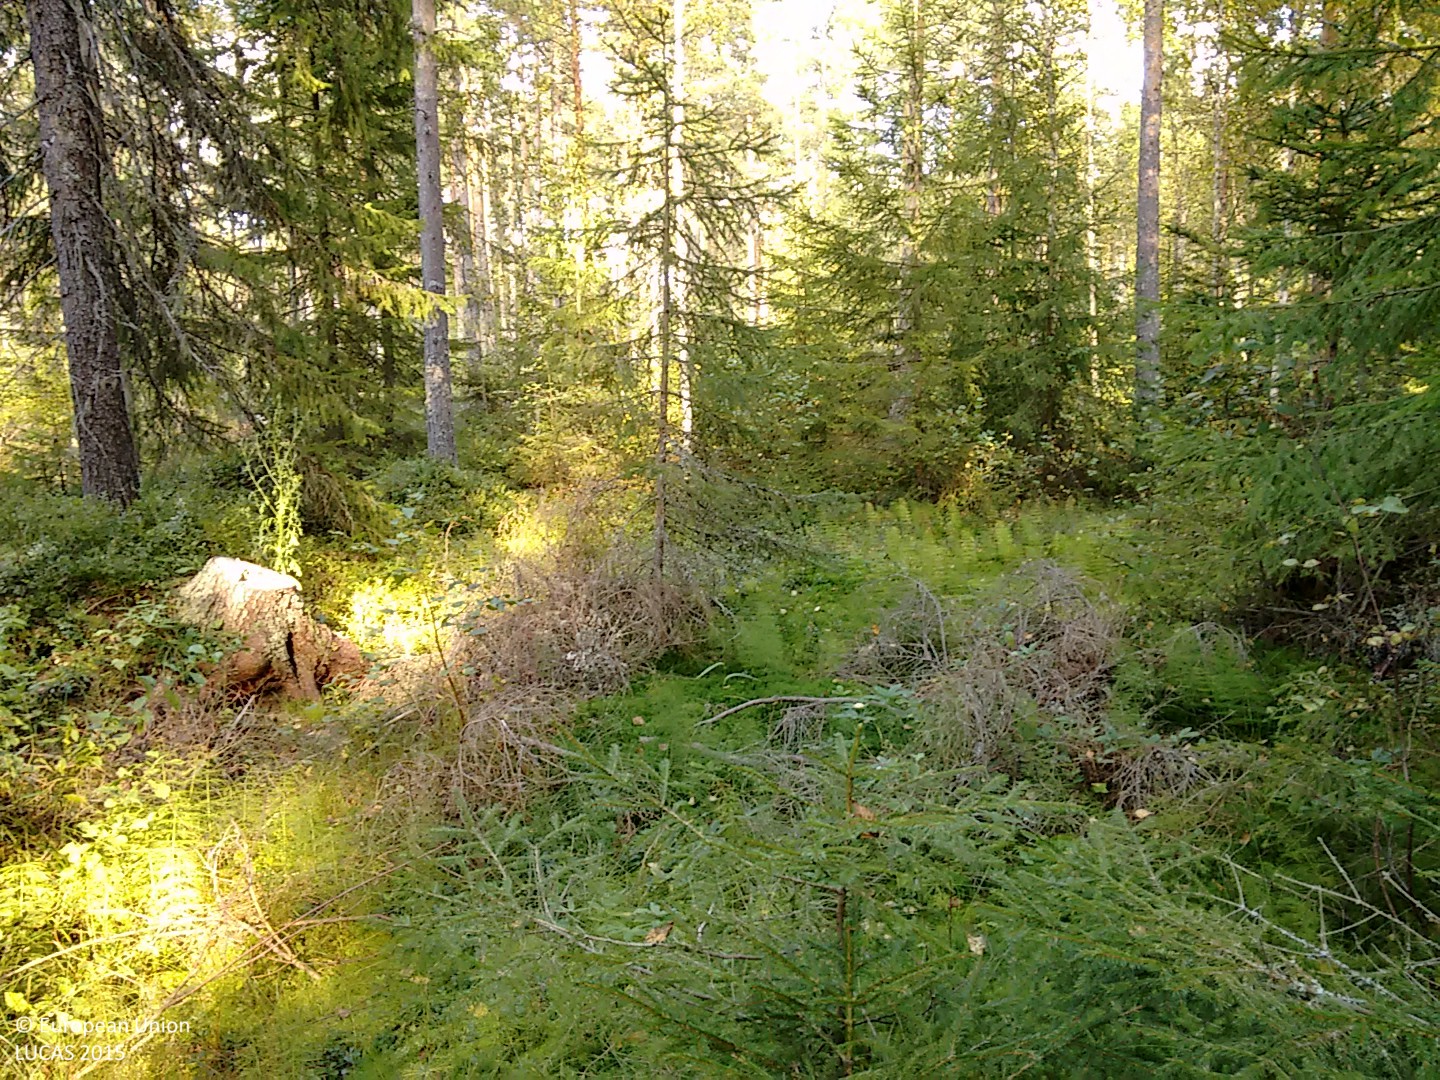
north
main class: Woodland
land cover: Spruce dominated mixed woodland
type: hemiboreal forest and nemoral coniferous forest and mixed broadleaved-coniferous forest
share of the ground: > 75 %
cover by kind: coniferous forest trees 55 %, broadleaved forest trees 30 %, shrubs 5 %, herbaceous plants 5 %, lichens and mosses 5 %
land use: Forestry
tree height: > 5 m
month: September
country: FI
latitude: 60.9760
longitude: 21.8276
